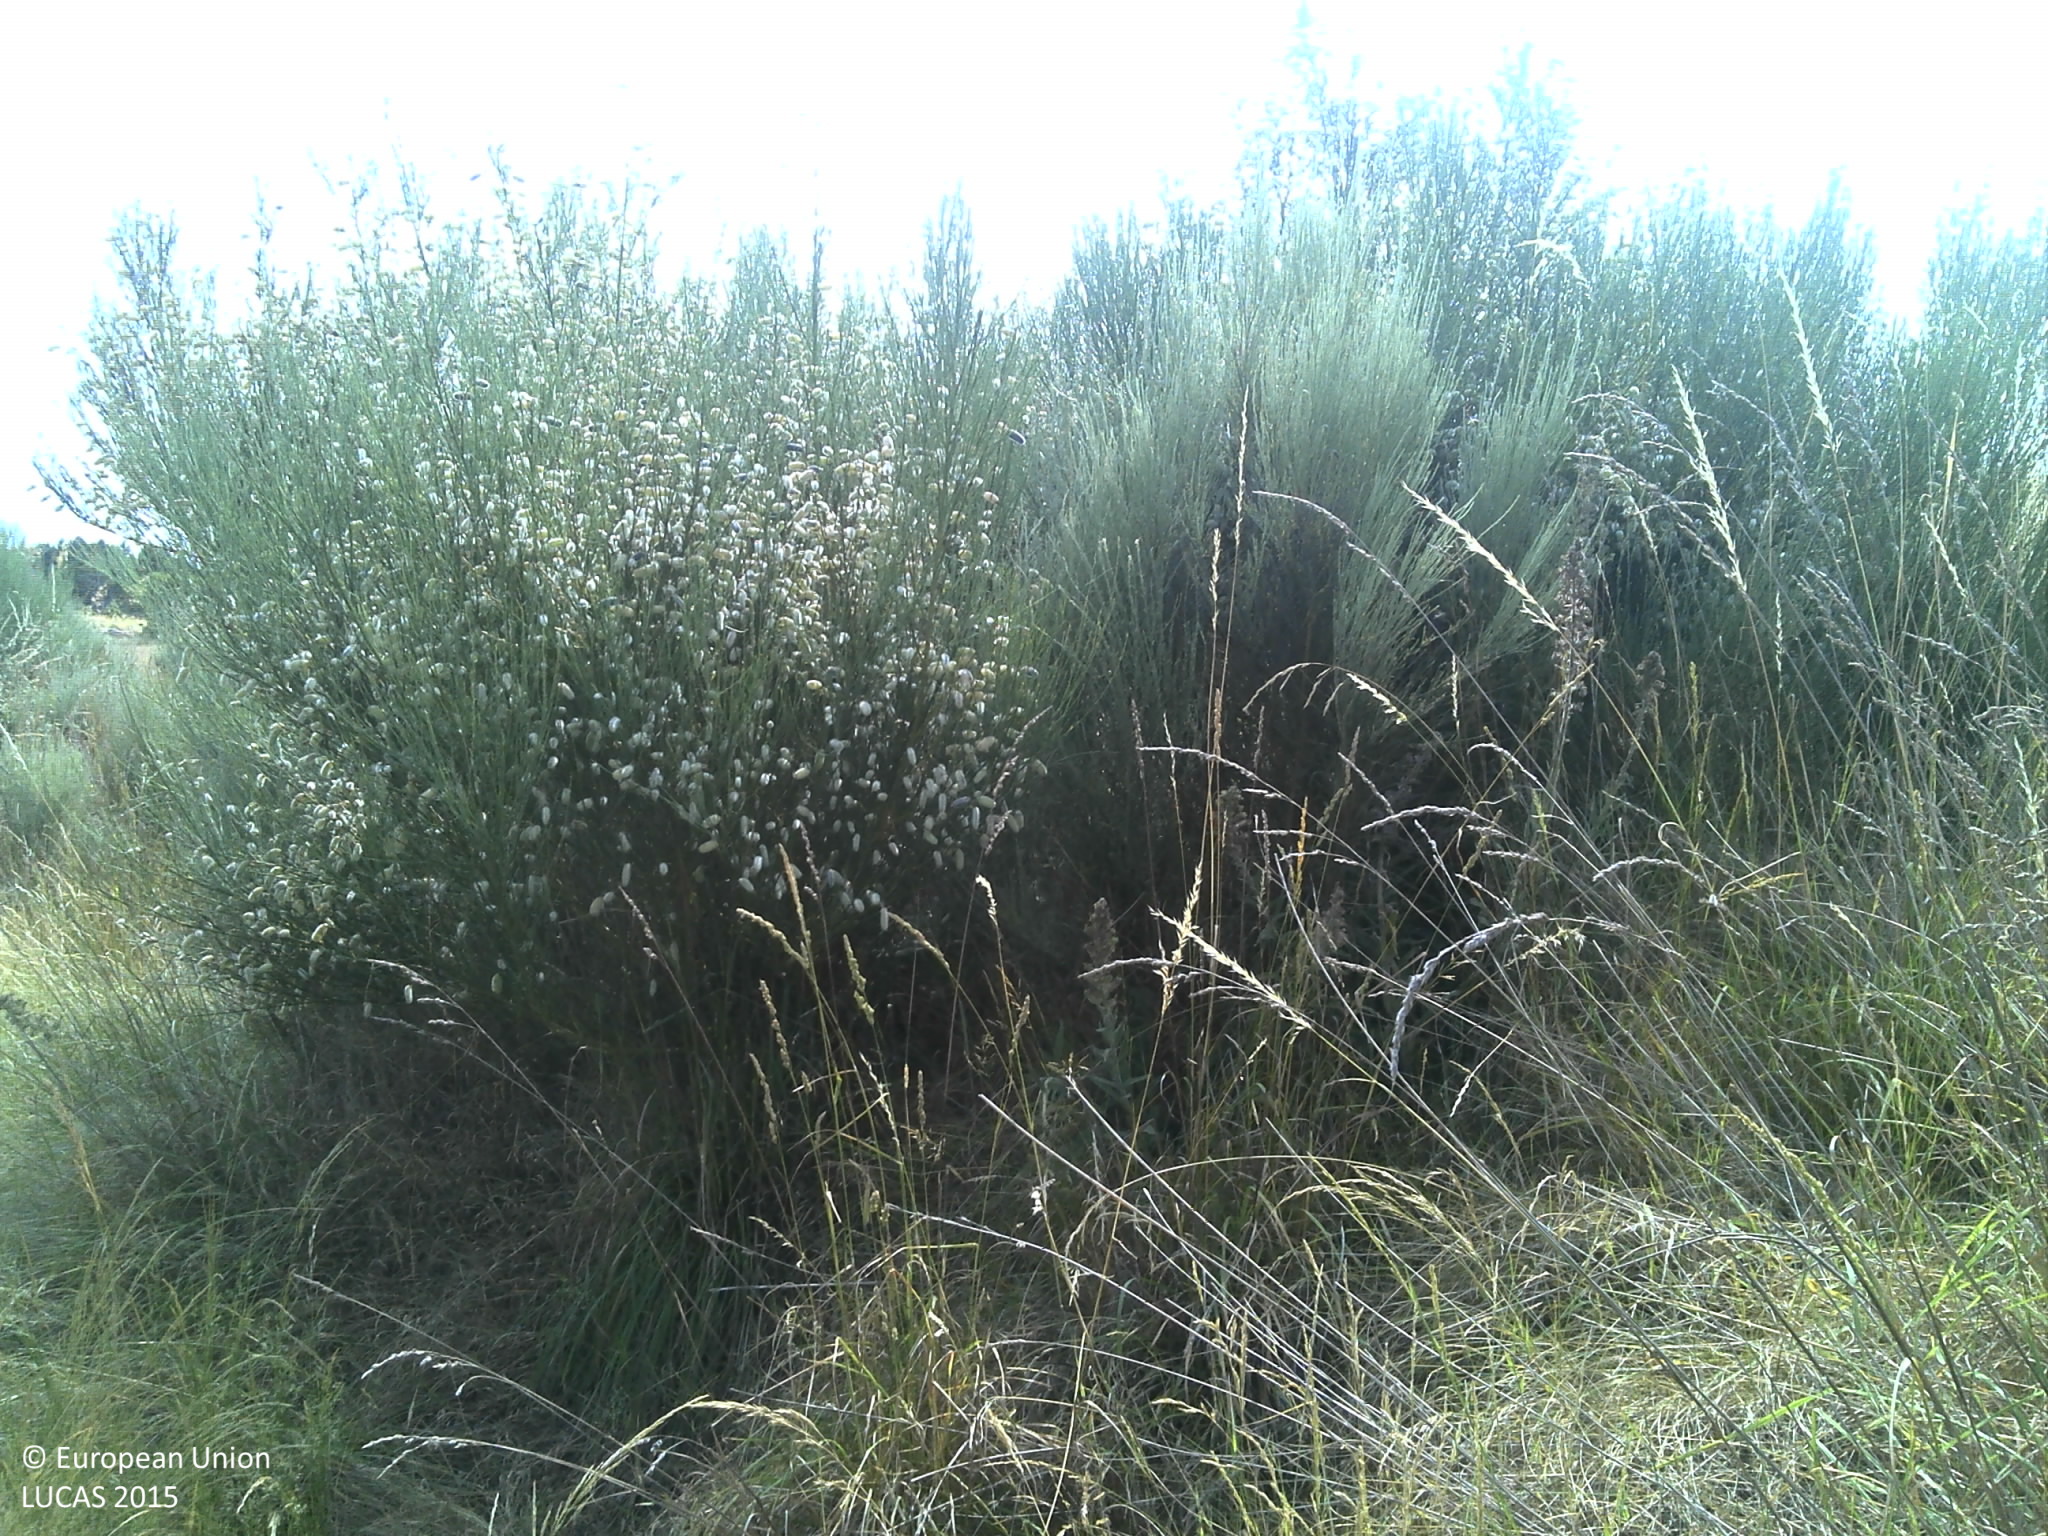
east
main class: Shrubland
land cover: Shrubland without tree cover
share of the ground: 50 - 75 %
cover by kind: shrubs 50 %, unconsolidated bare surface 25 %, herbaceous plants 20 %, consolidated bare surface 5 %
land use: Semi-natural and natural areas not in use
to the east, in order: Shrubland without tree cover; Grassland without tree/shrub cover; Grassland with sparse tree/shrub cover; Abandoned hedges; Tracks; Dry stone walls; Grassland without tree/shrub cover; Dry stone walls; Grassland with sparse tree/shrub cover; Broadleaved woodland
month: July
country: PT
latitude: 40.9322
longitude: -7.3956
